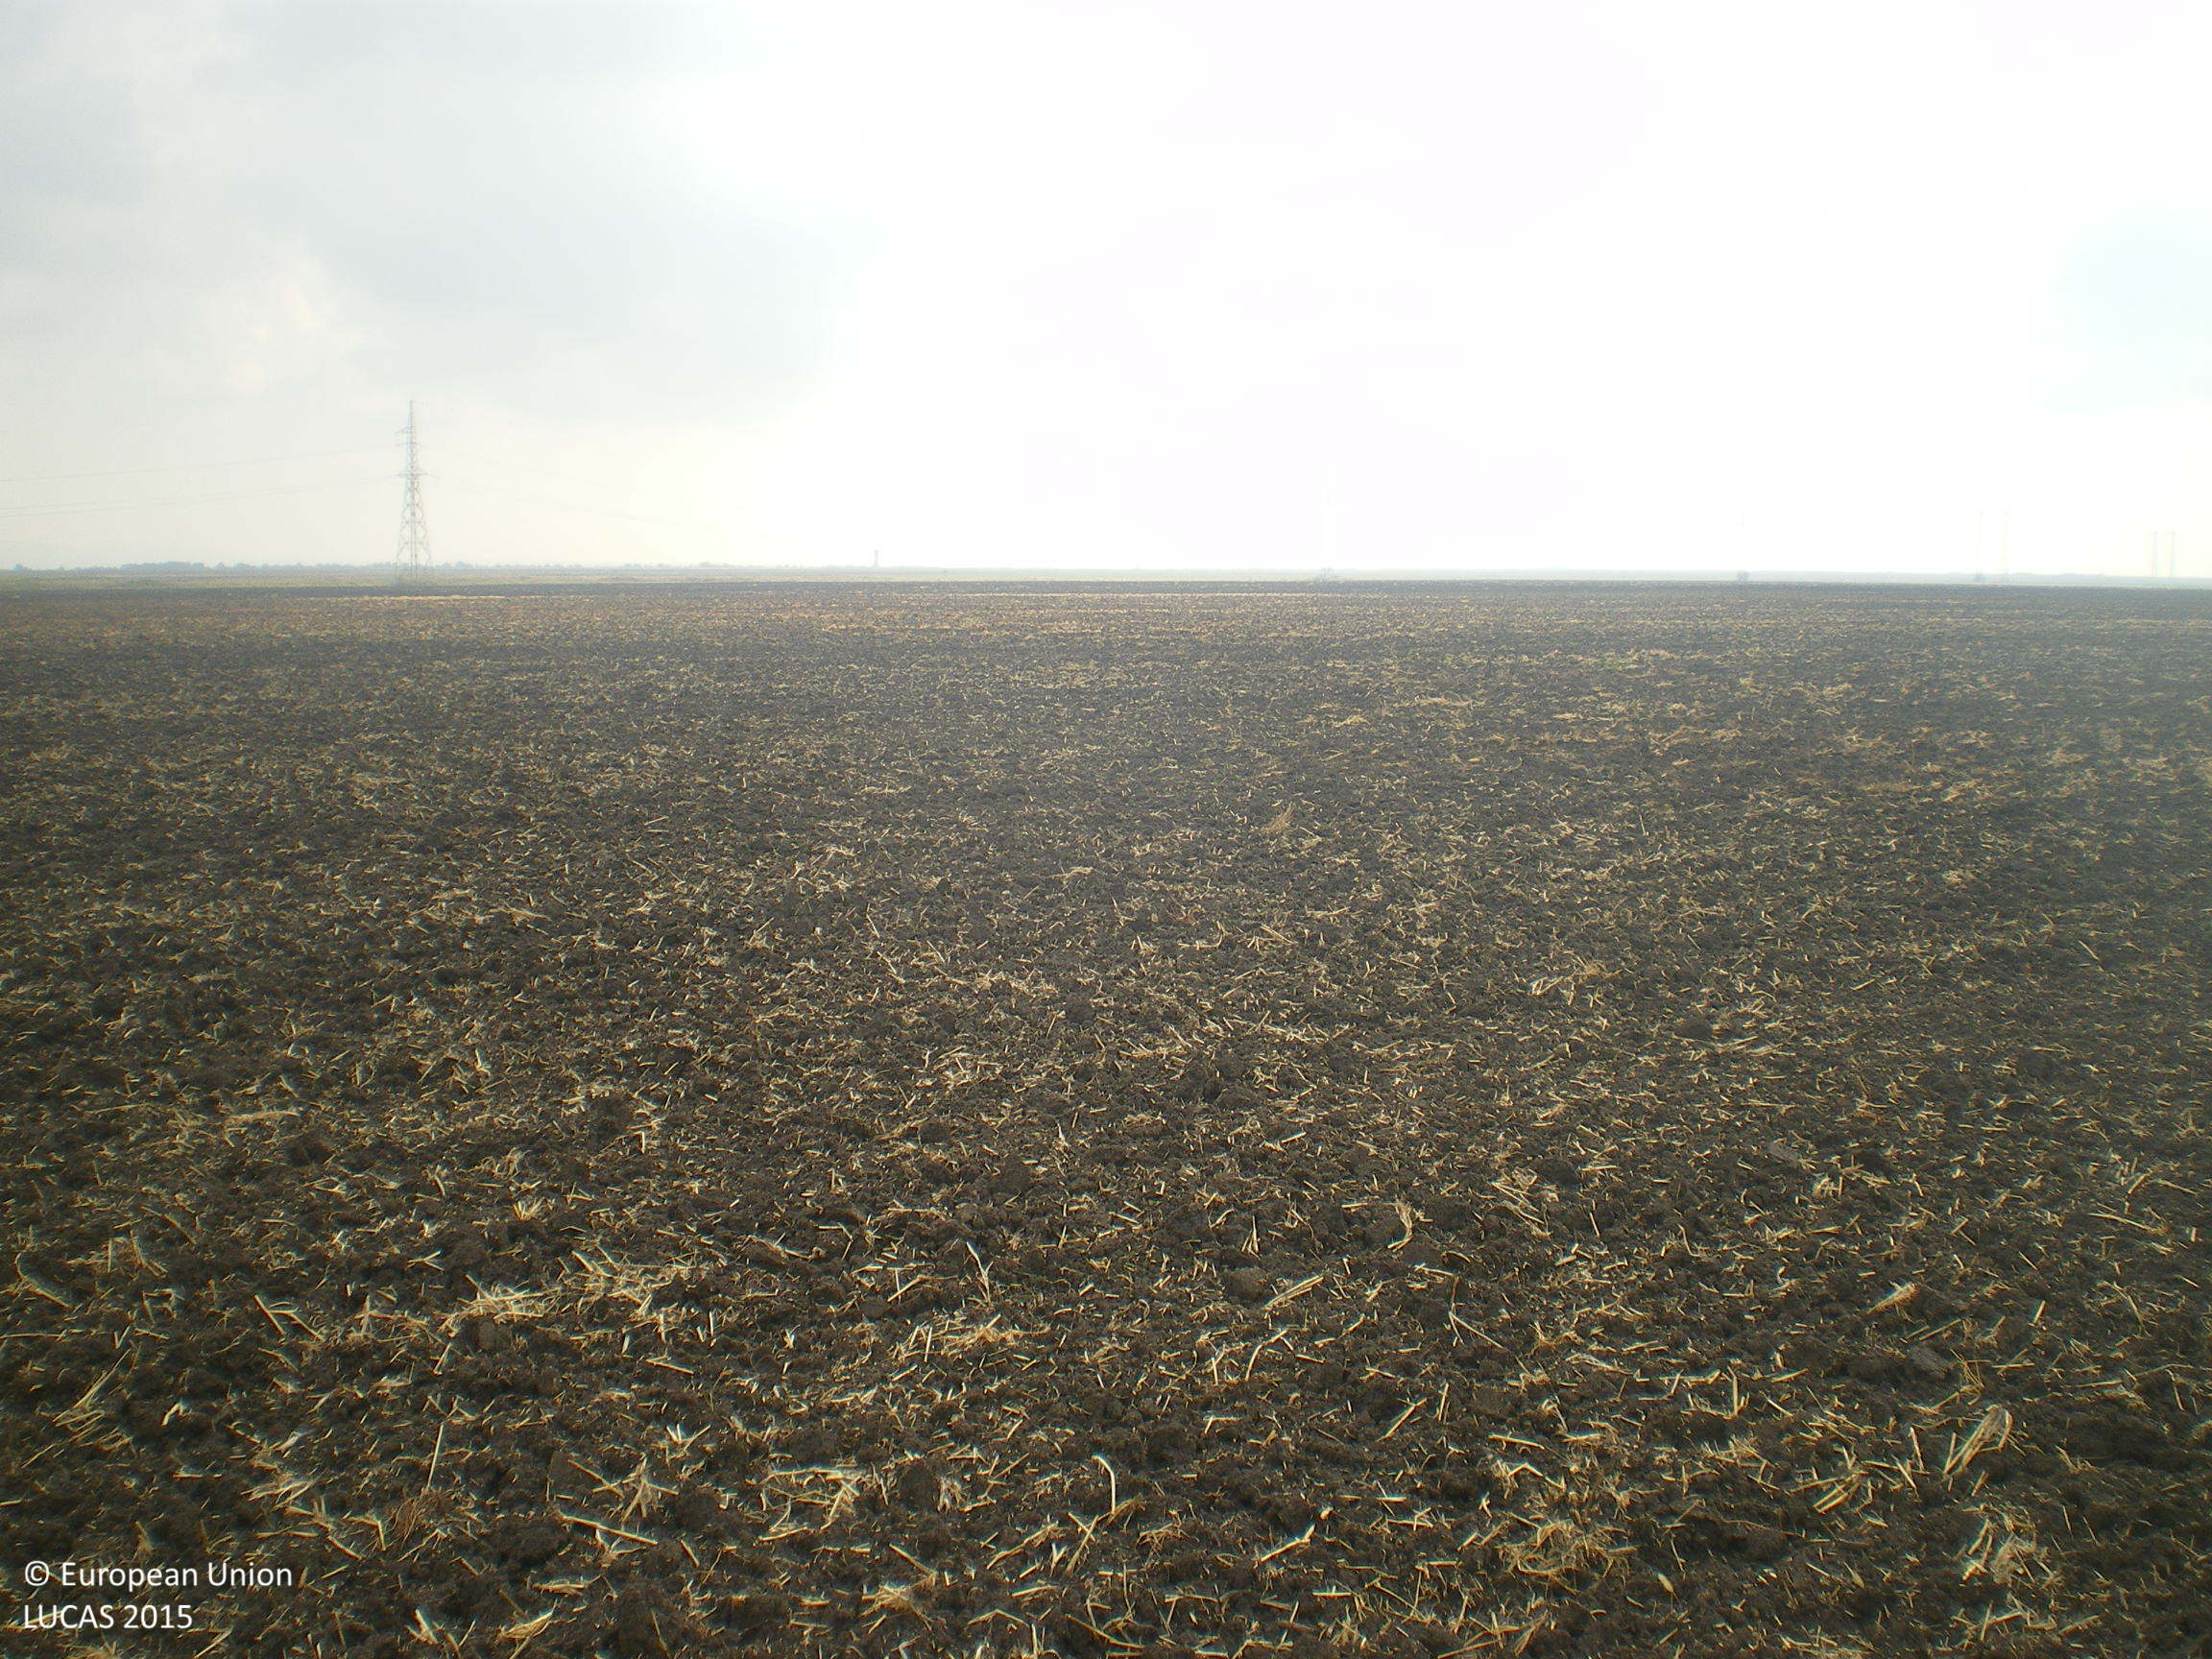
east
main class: Cropland
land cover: Common wheat
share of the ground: < 10 %
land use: Agriculture (excluding fallow land and kitchen gardens)
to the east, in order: Common wheat
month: August
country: BG
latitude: 42.3626
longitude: 25.8979
